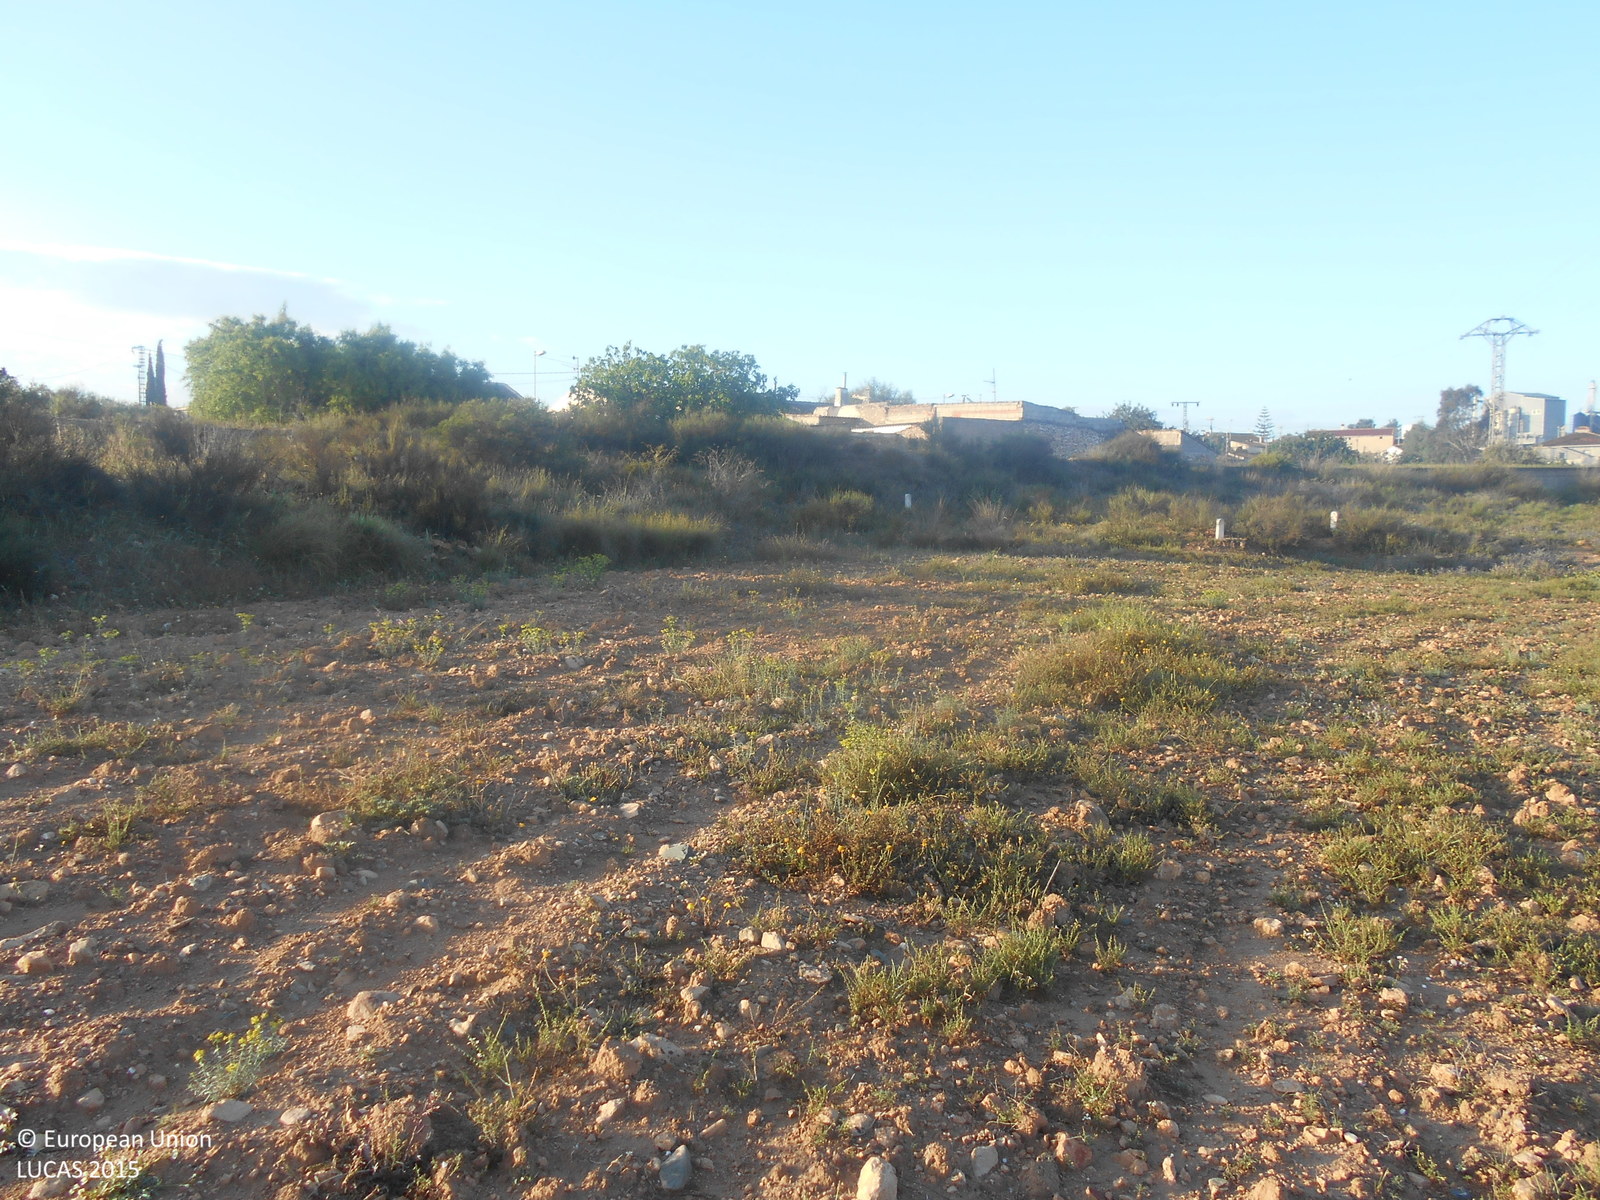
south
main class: Grassland
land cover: Spontaneously vegetated surfaces
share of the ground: 25 - 50 %
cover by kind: unconsolidated bare surface 70 %, herbaceous plants 30 %
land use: Fallow land
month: April
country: ES
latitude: 37.7176
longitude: -1.4057
